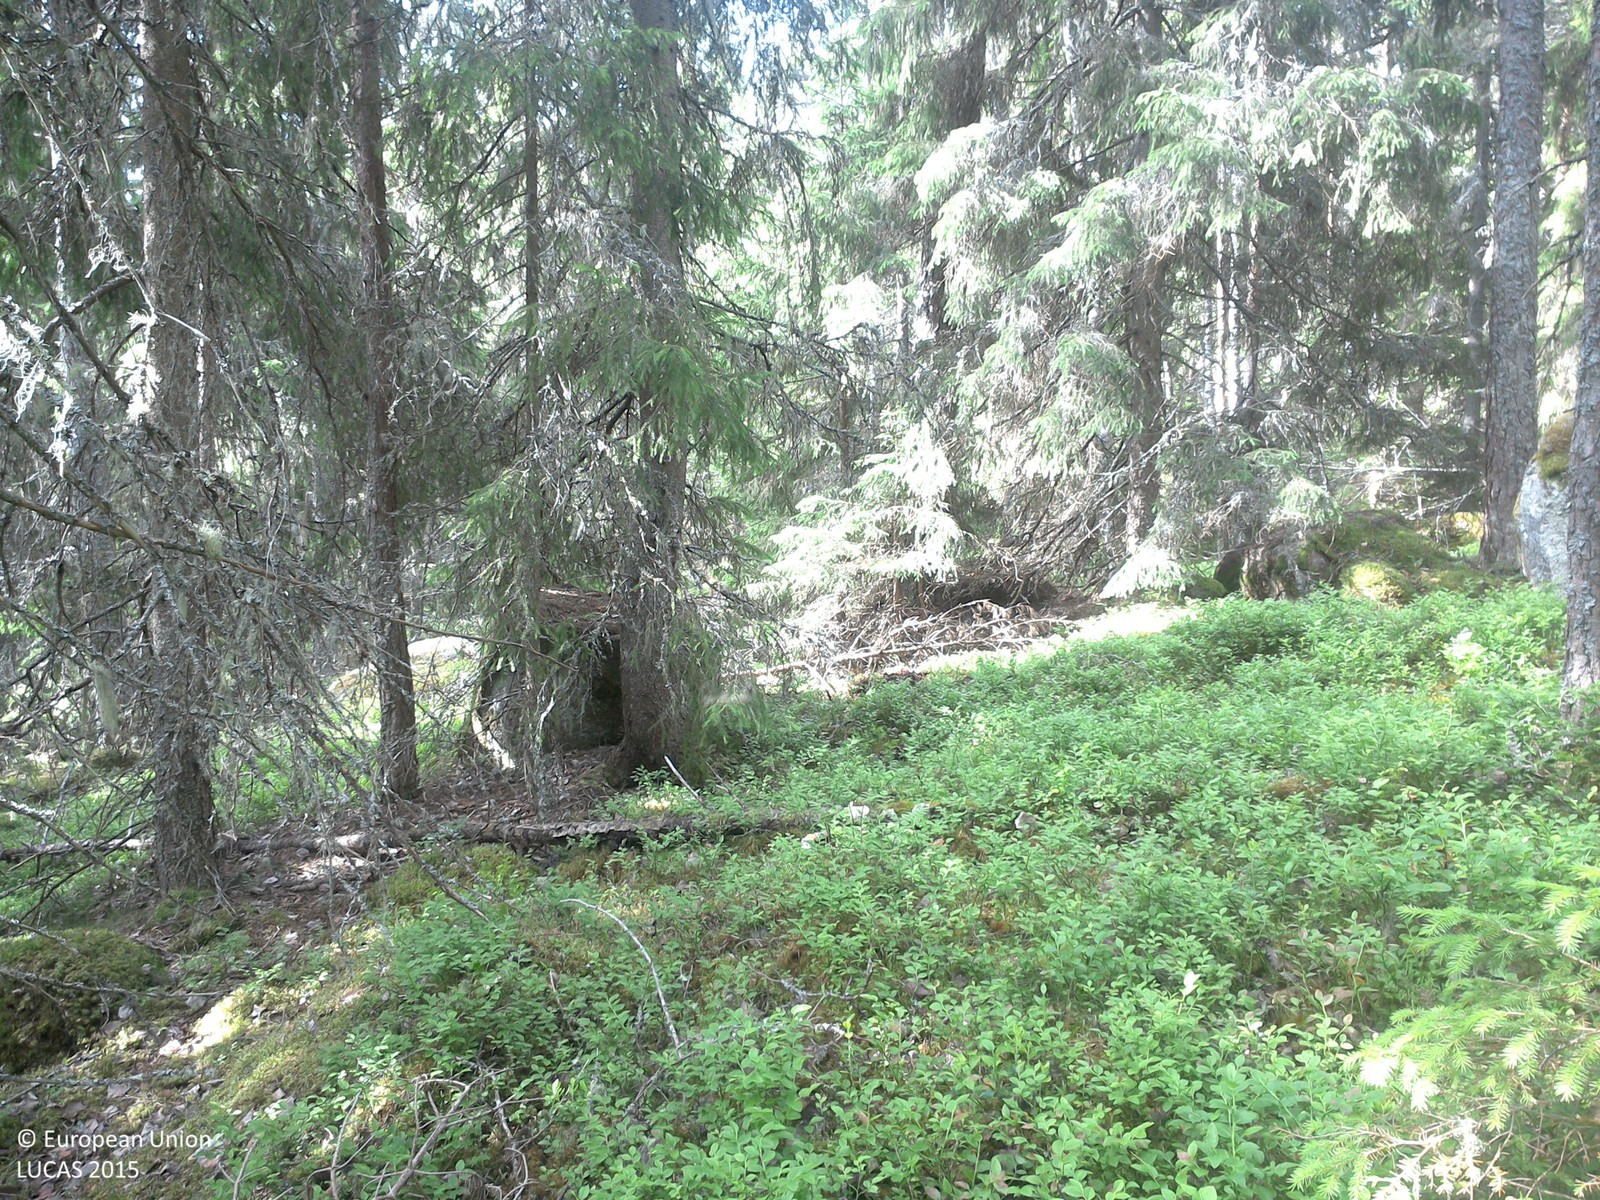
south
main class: Woodland
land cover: Spruce dominated coniferous woodland
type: boreal forest
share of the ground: 50 - 75 %
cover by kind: coniferous forest trees 60 %, lichens and mosses 20 %, herbaceous plants 15 %, broadleaved forest trees 5 %
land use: Forestry
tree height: > 5 m
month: June
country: SE
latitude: 58.1424
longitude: 15.5159
